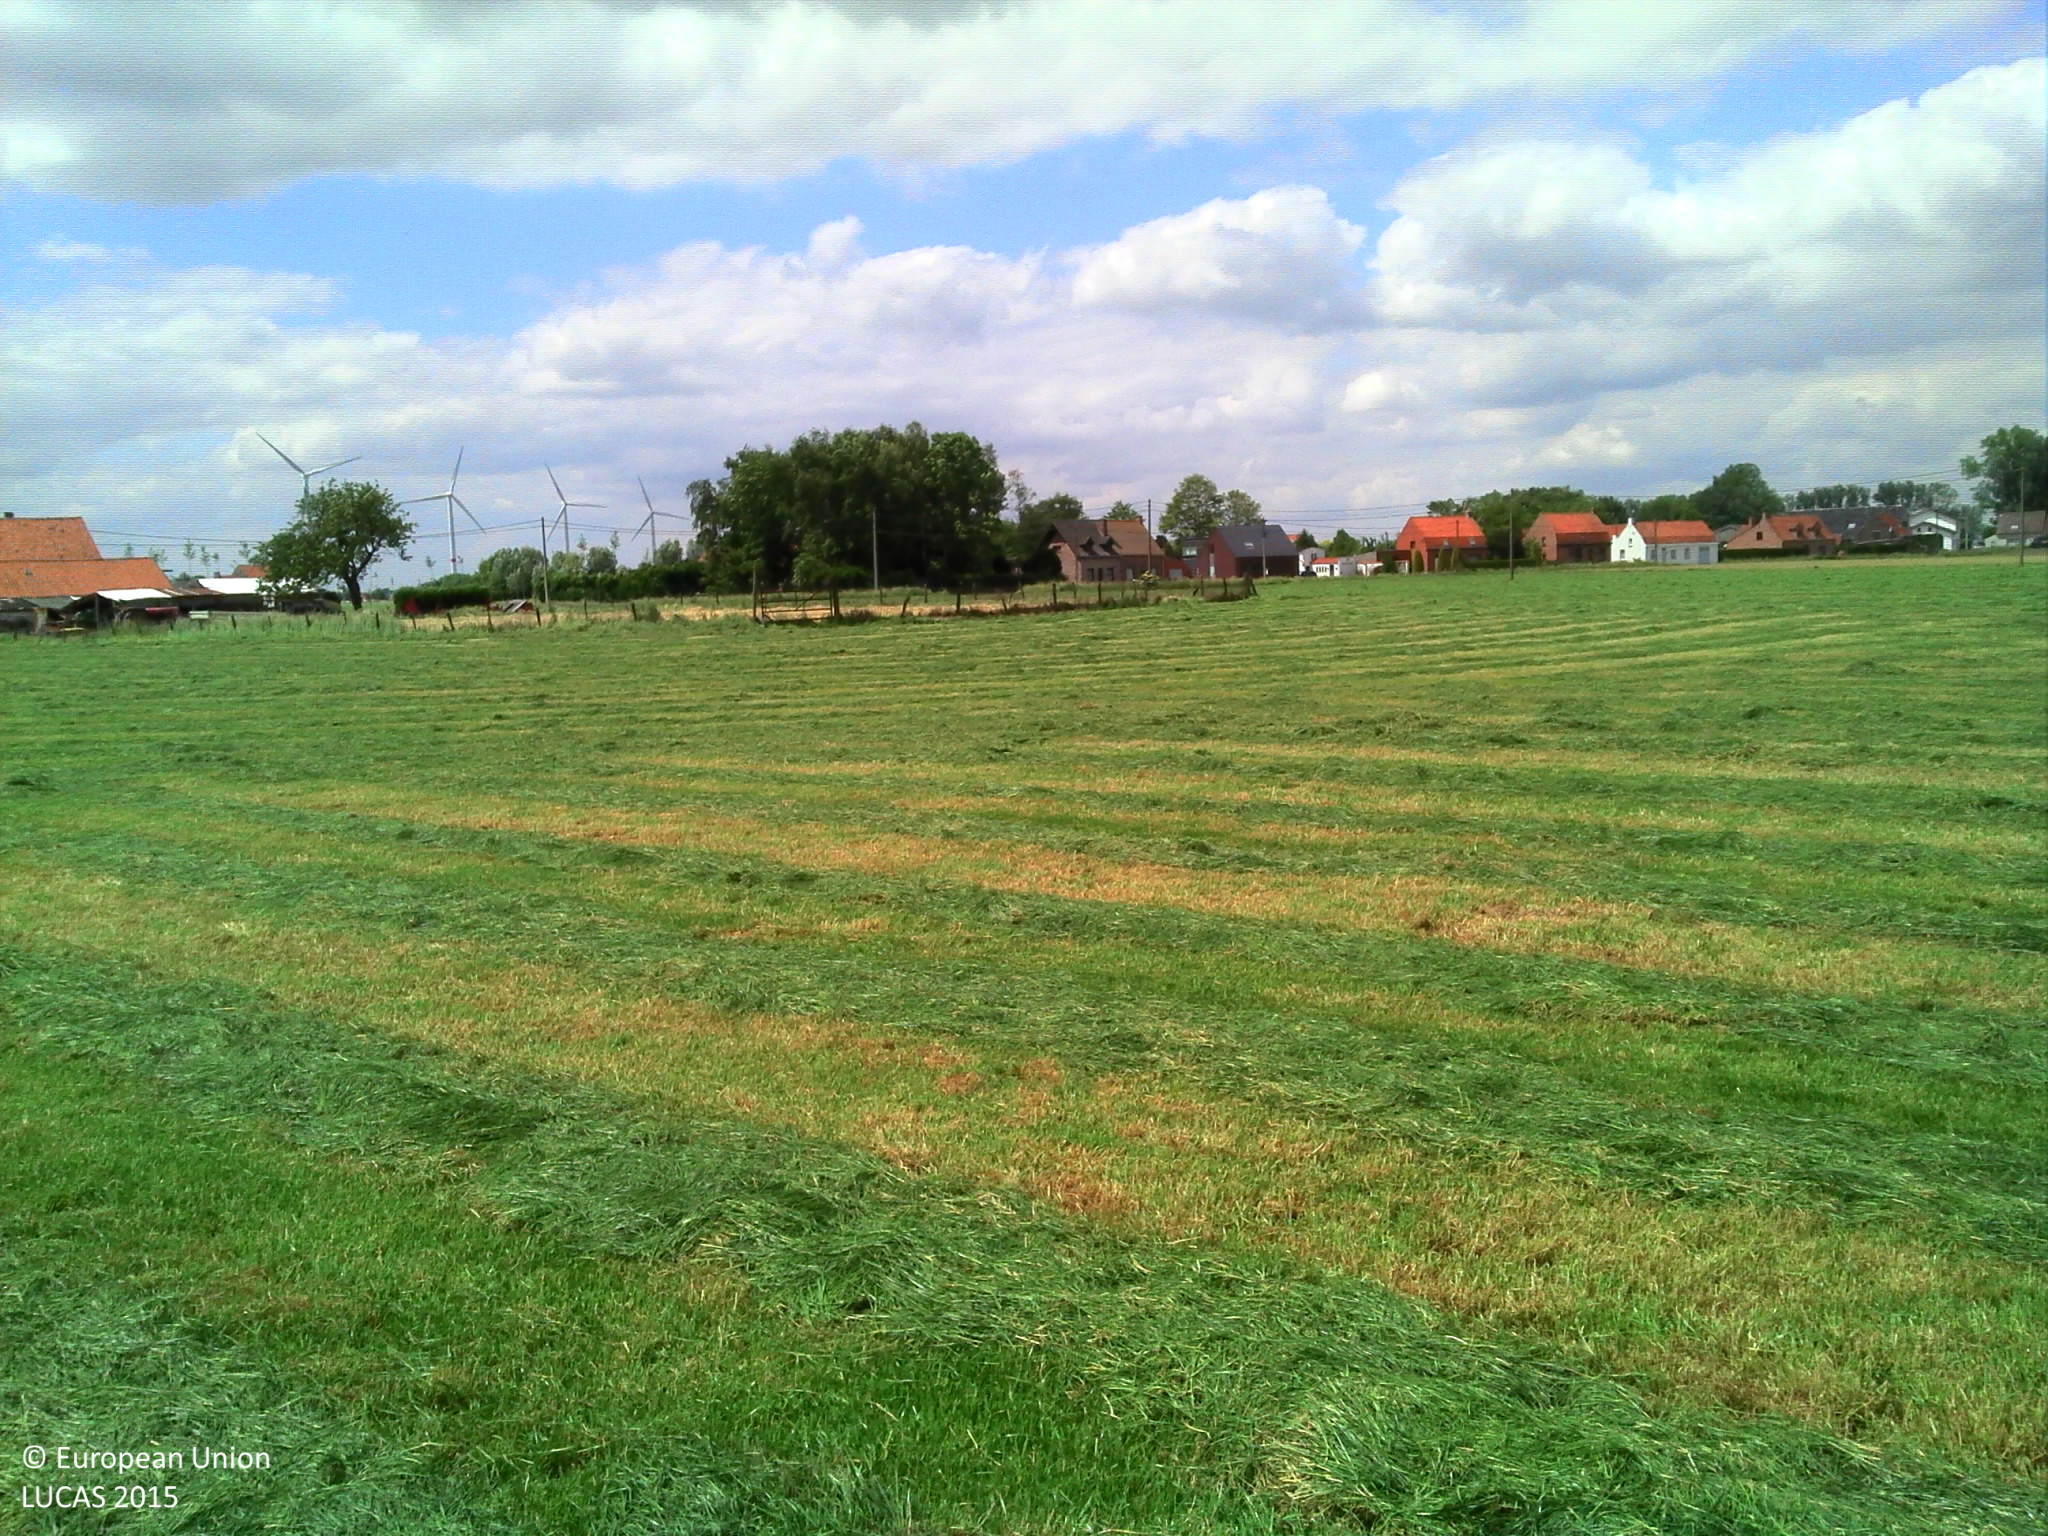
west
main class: Cropland
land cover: Temporary grasslands
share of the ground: > 75 %
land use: Agriculture (excluding fallow land and kitchen gardens)
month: June
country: BE
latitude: 50.8583
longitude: 2.7862
